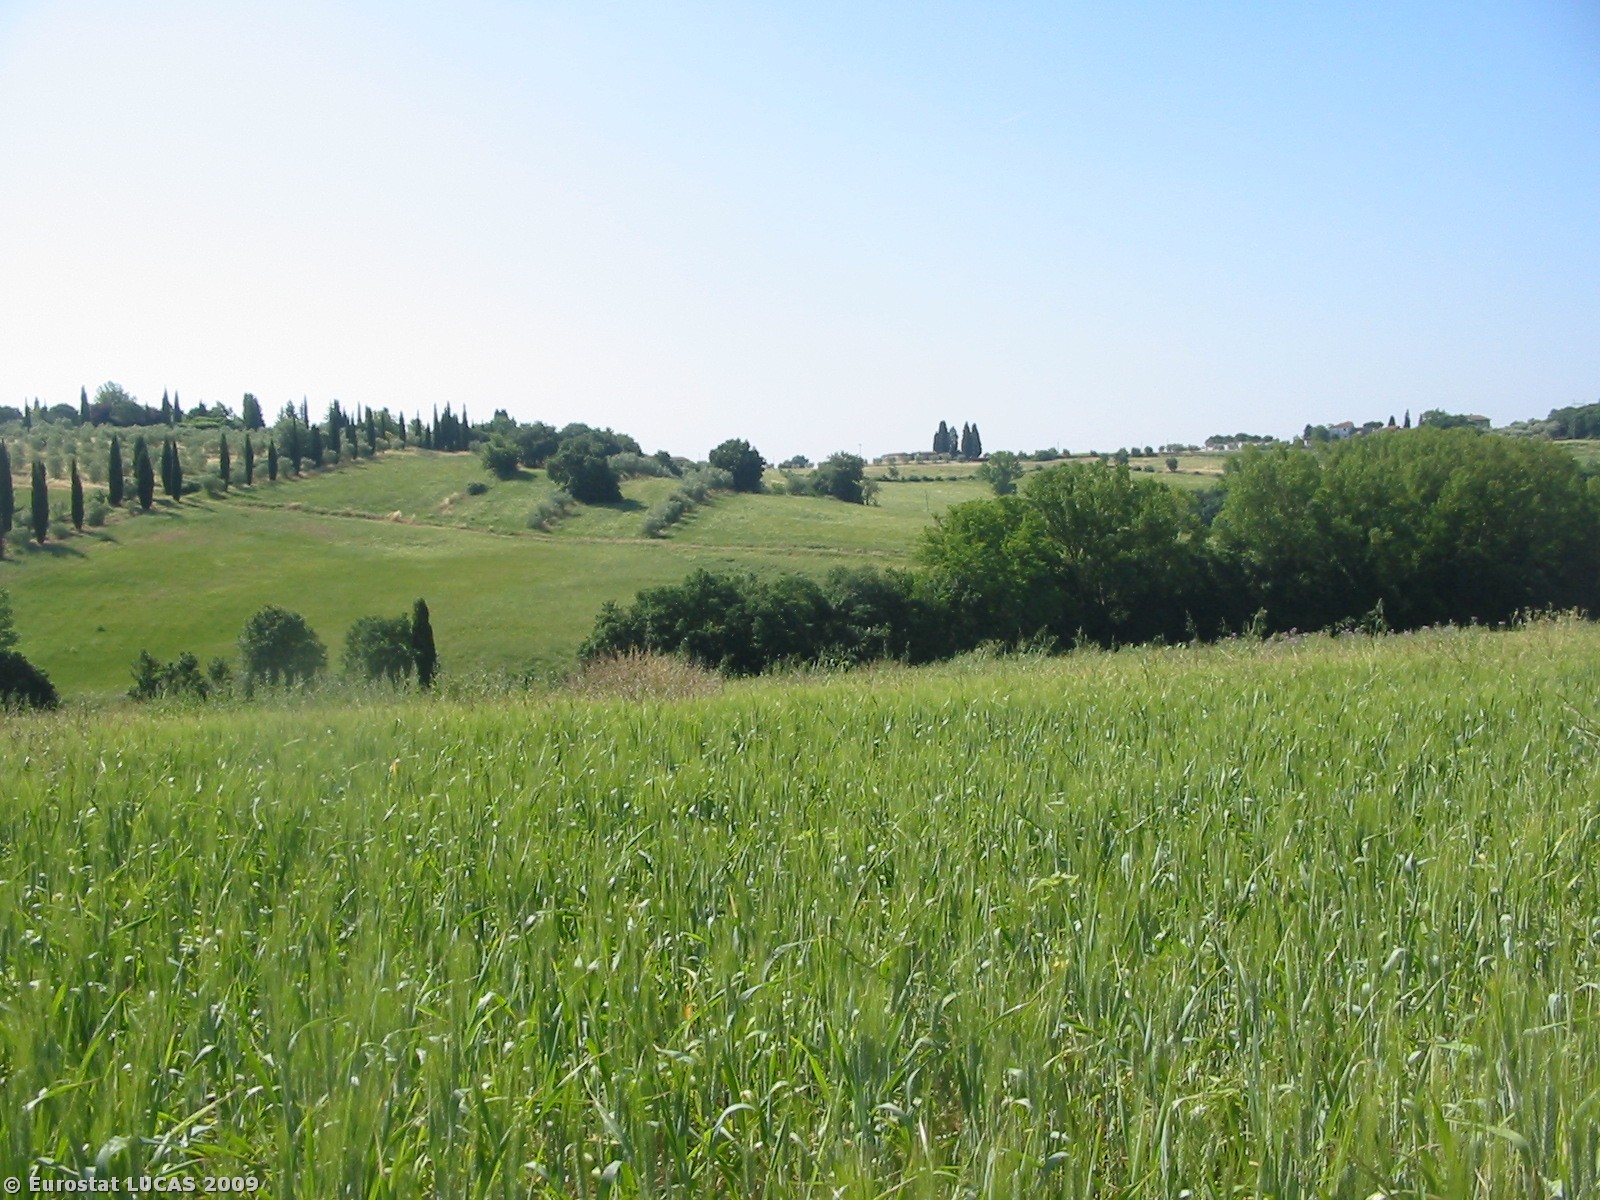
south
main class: Cropland
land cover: Durum wheat
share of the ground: > 75 %
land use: Agriculture (excluding fallow land and kitchen gardens)
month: June
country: IT
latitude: 43.2141
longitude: 11.9025
